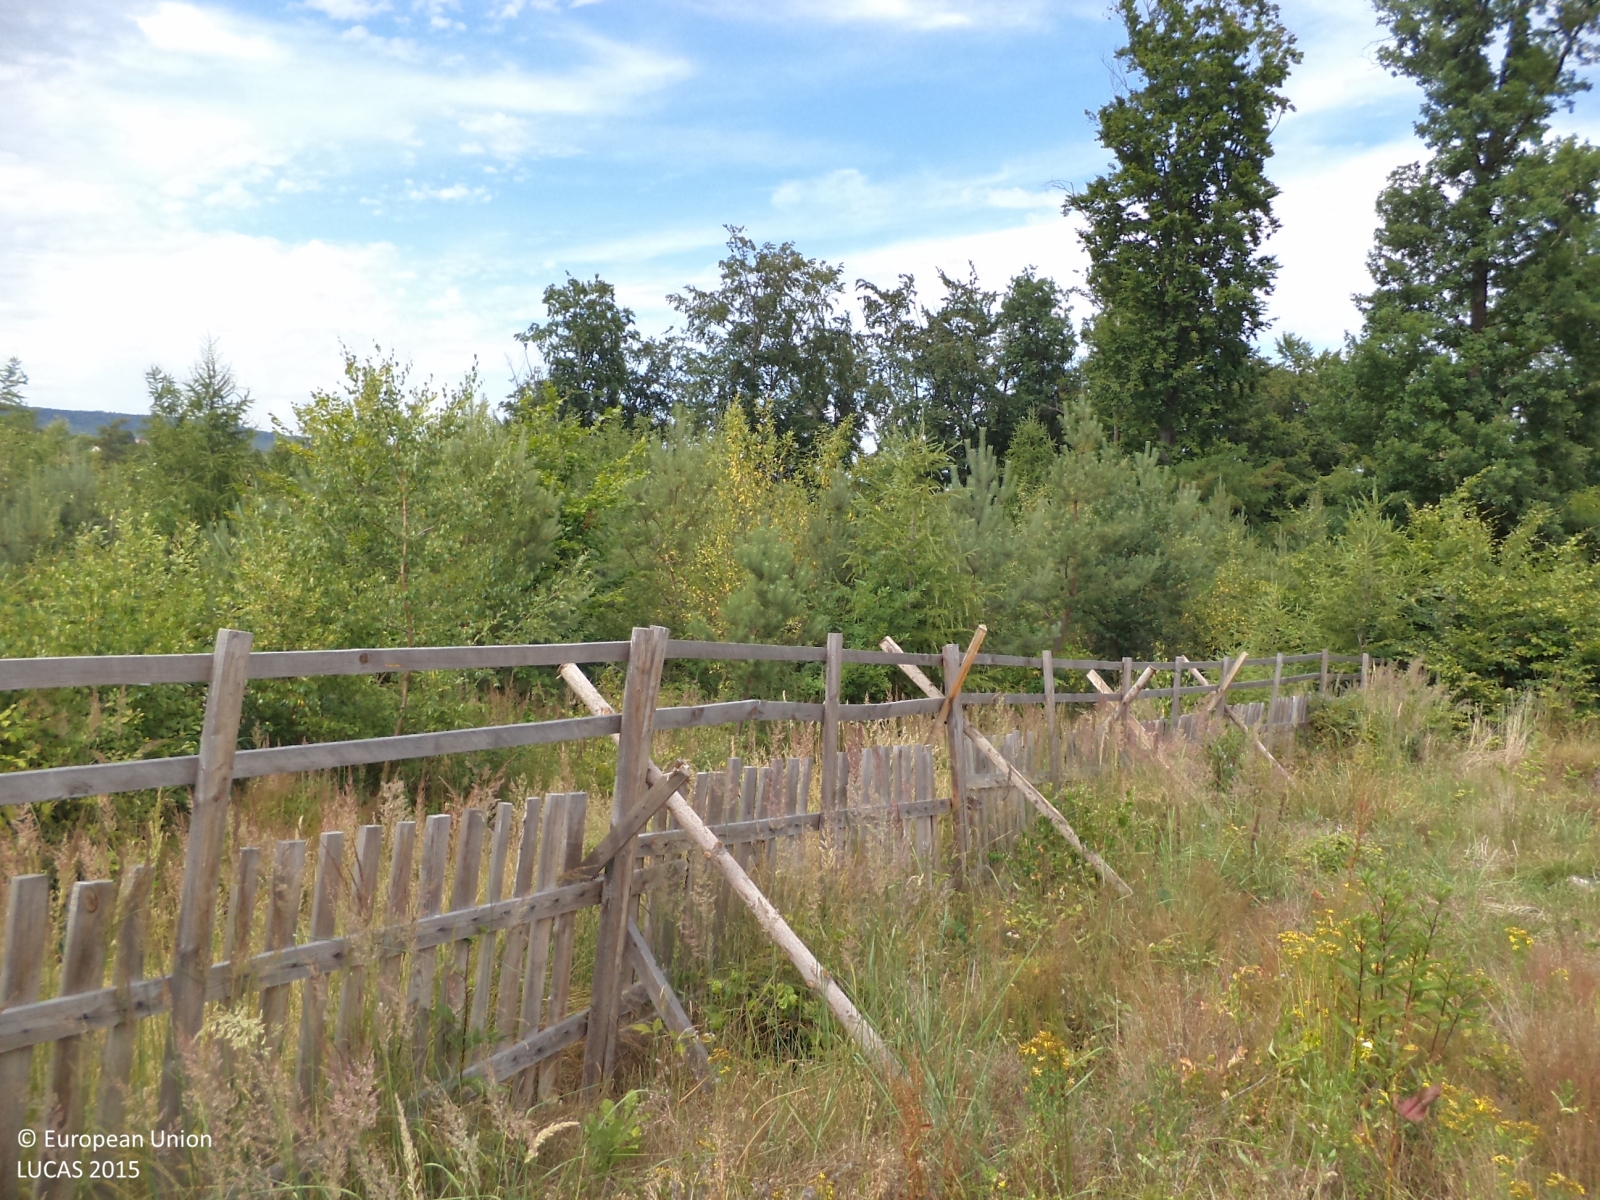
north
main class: Grassland
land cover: Grassland with sparse tree/shrub cover
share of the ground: > 75 %
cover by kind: herbaceous plants 95 %, broadleaved forest trees 5 %
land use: Forestry
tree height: < 5 m
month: July
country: CZ
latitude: 49.9351
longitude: 13.9715
